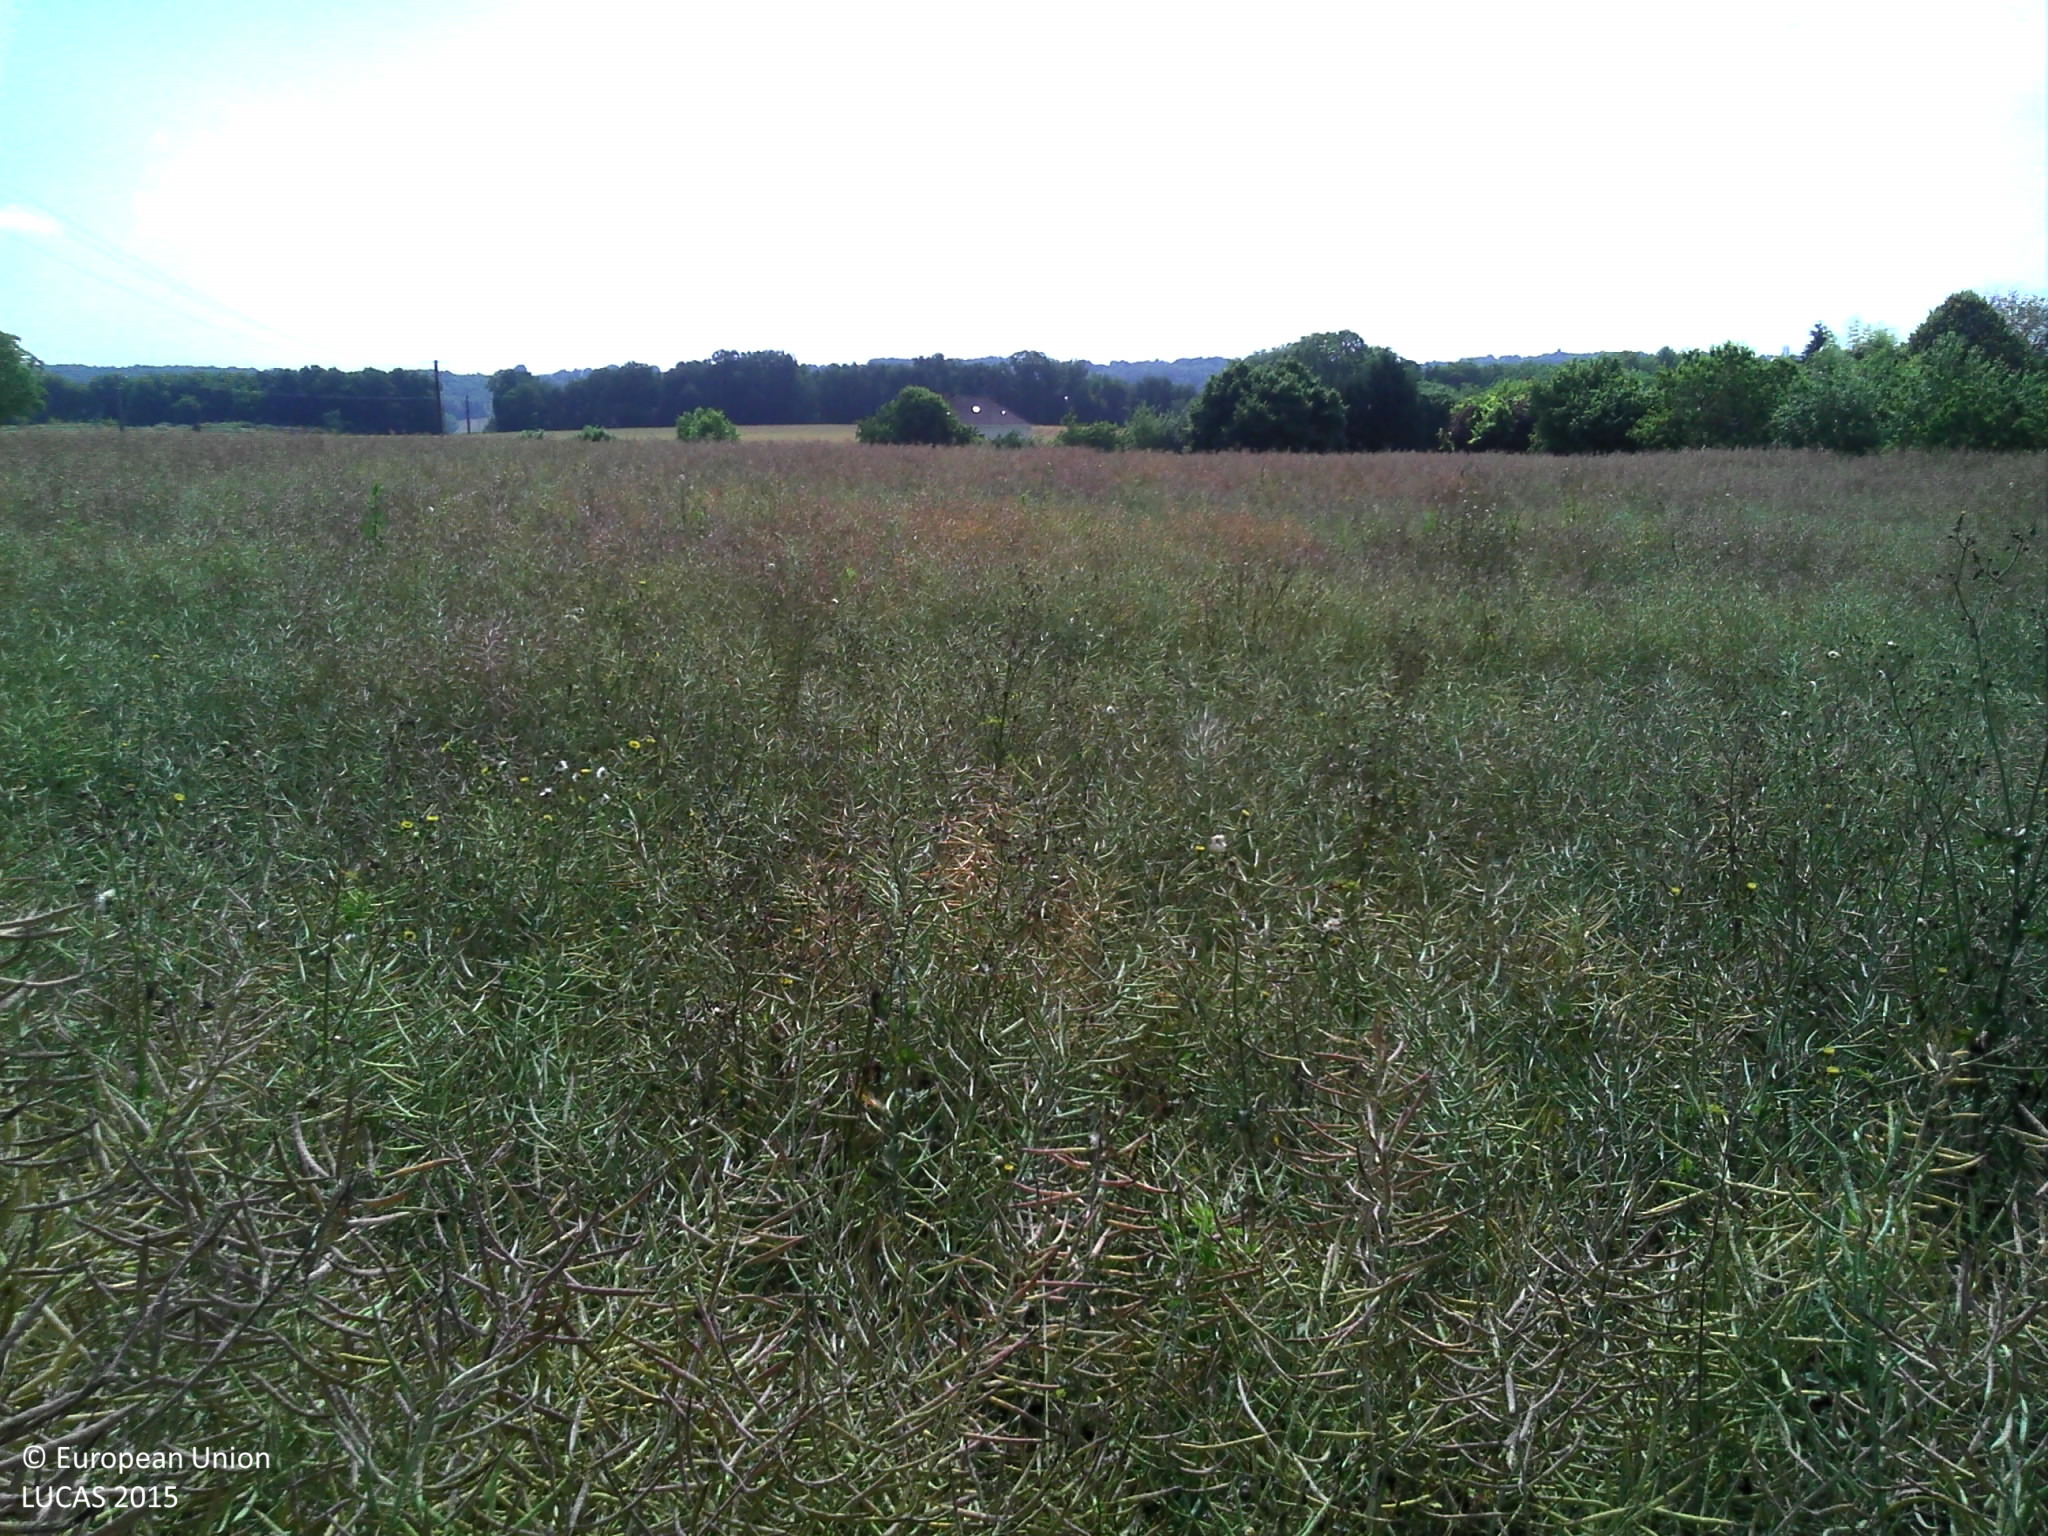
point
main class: Cropland
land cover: Rape and turnip rape
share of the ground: > 75 %
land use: Agriculture (excluding fallow land and kitchen gardens)
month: June
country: FR
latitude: 46.5756
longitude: 0.8643
